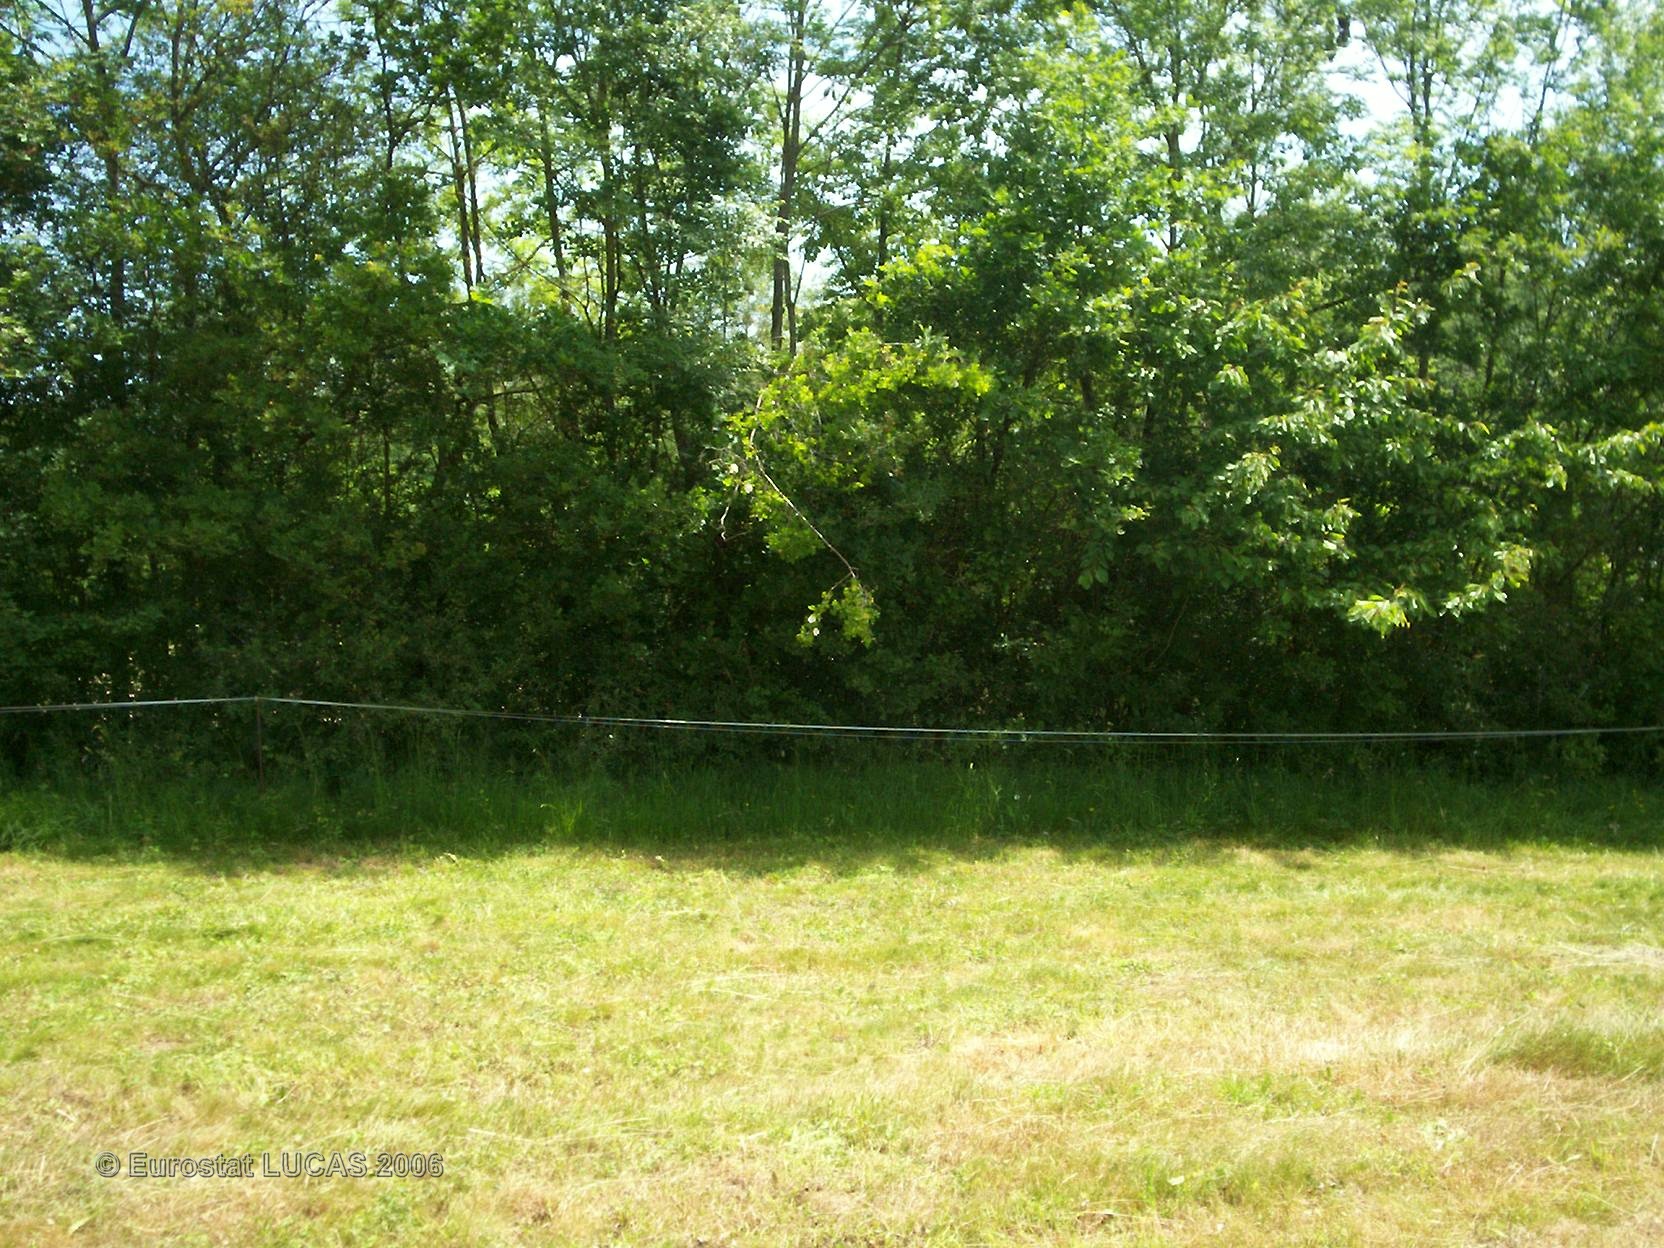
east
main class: Grassland
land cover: Grassland without tree/shrub cover
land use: Agriculture (excluding fallow land and kitchen gardens)
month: June
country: FR
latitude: 46.3160
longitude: 6.0943
